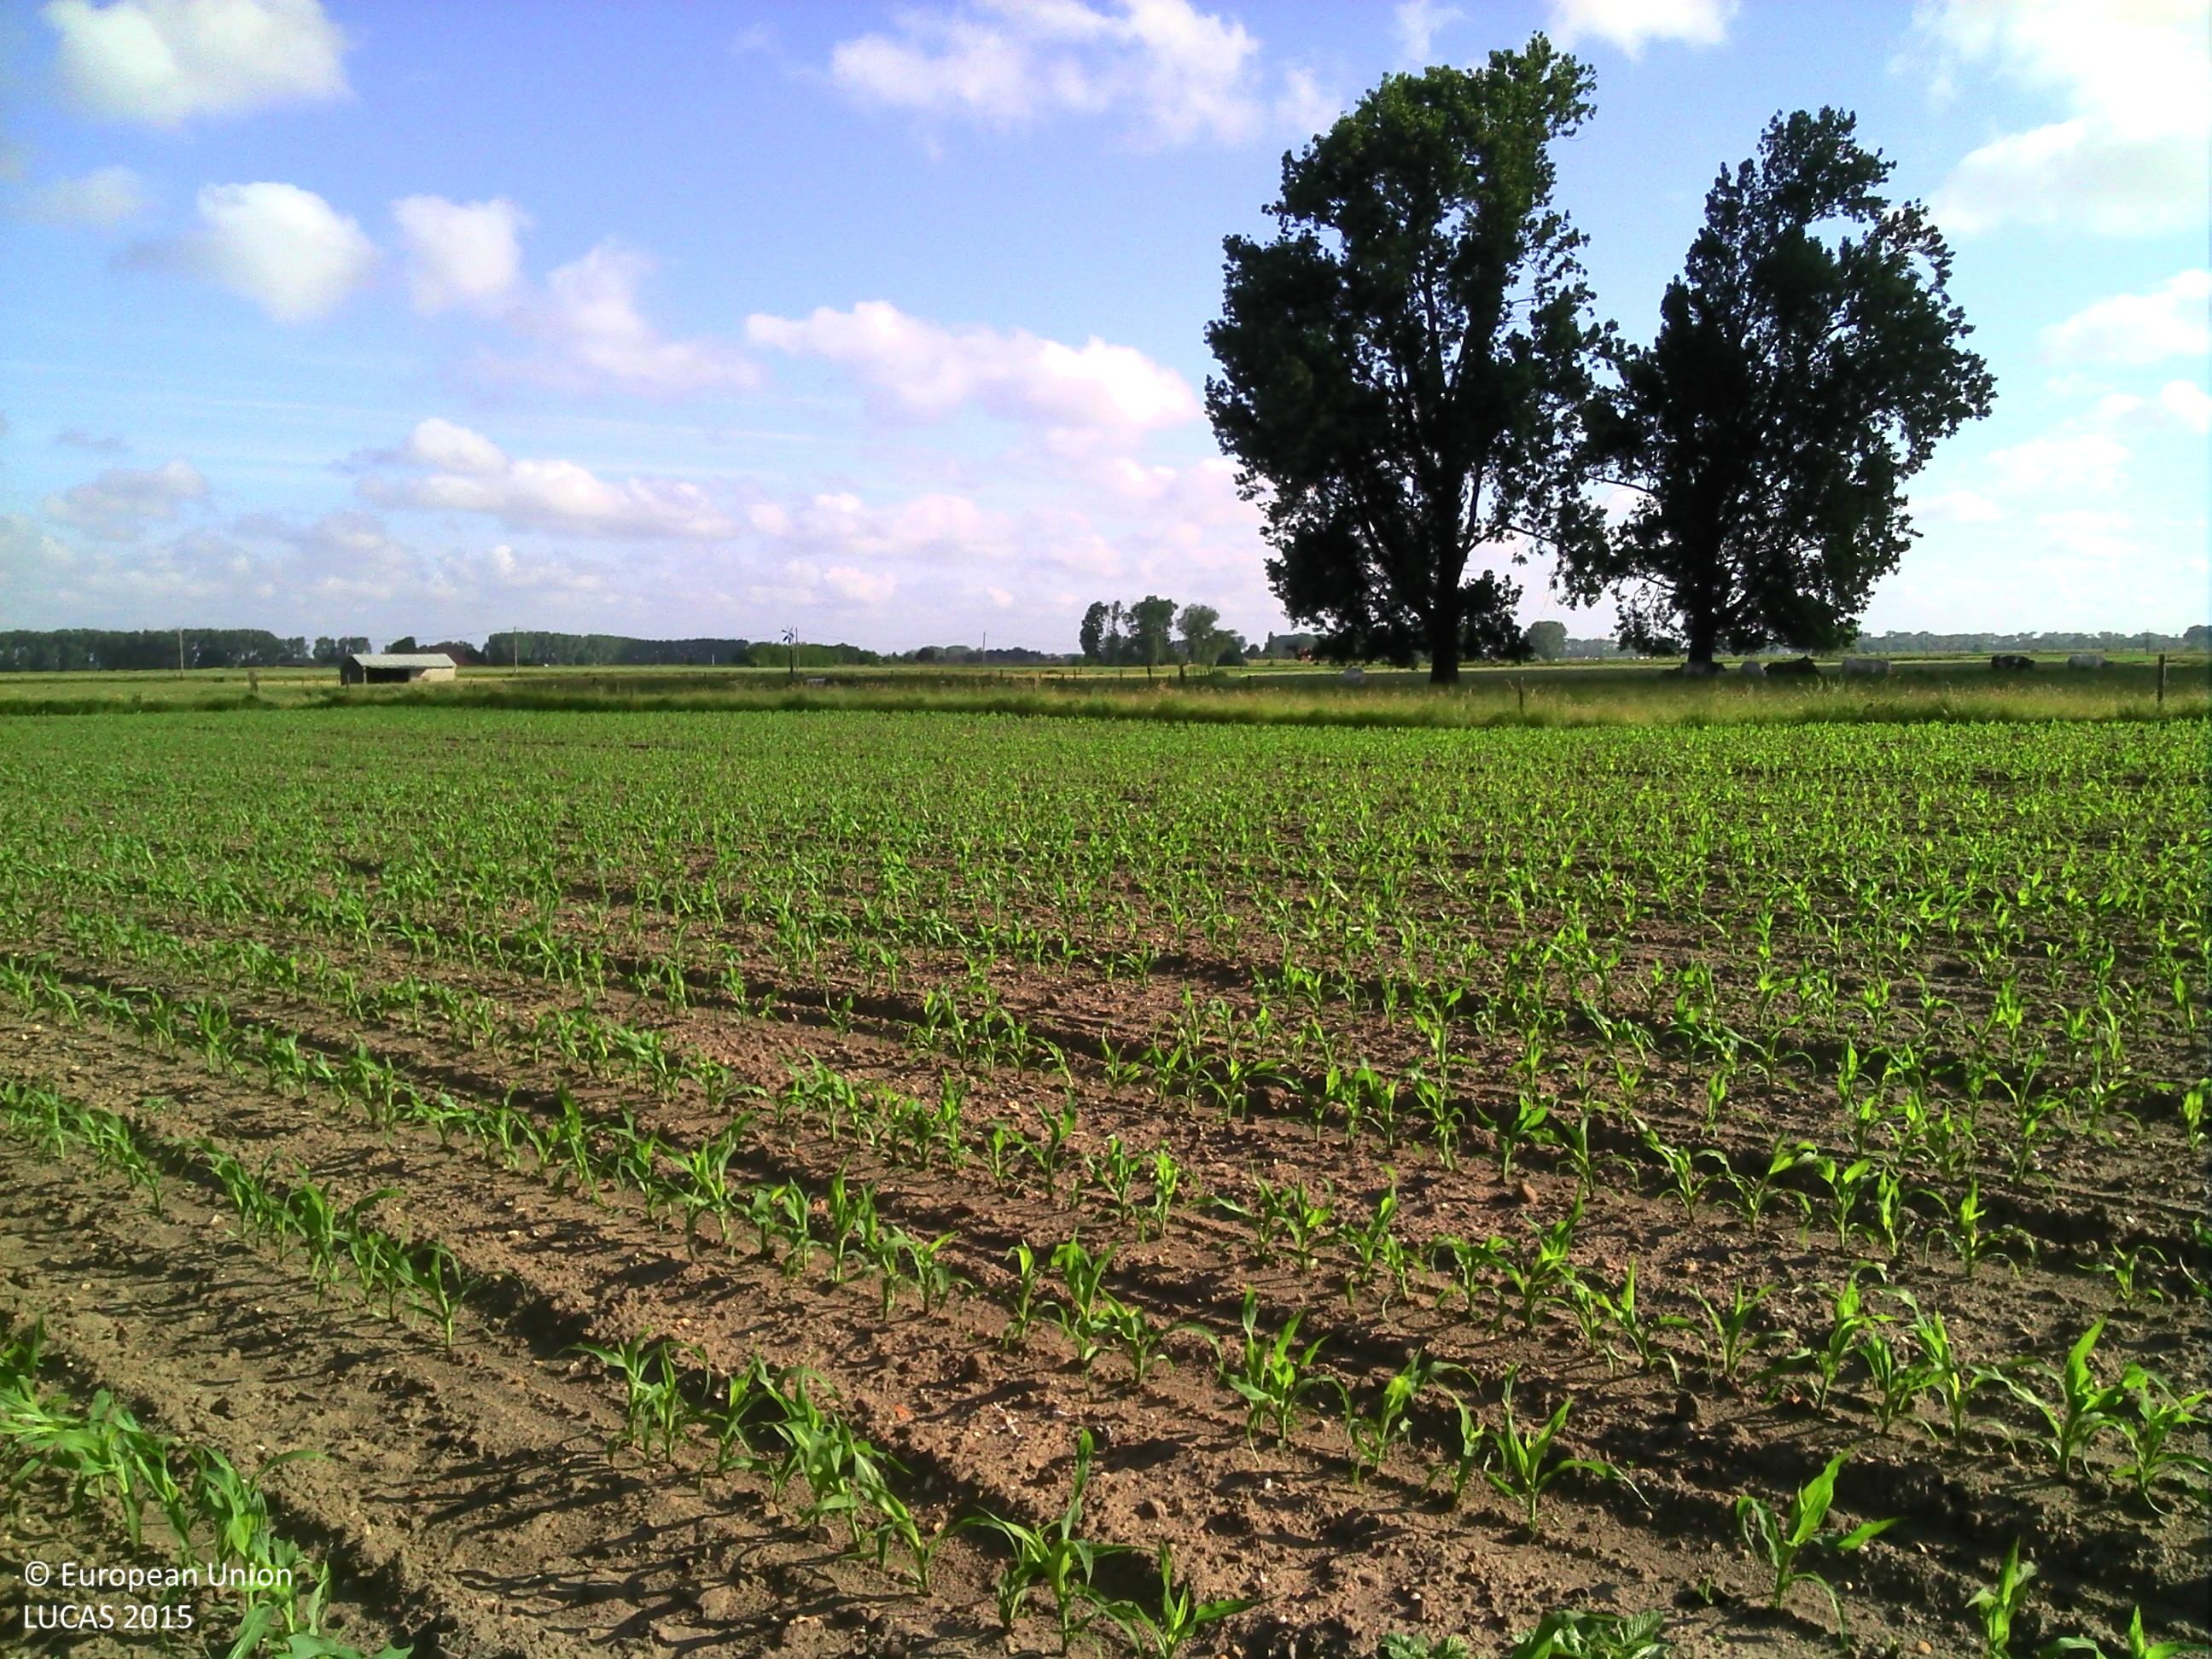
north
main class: Cropland
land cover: Maize
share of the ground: 10 - 25 %
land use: Agriculture (excluding fallow land and kitchen gardens)
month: June
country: BE
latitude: 51.0608
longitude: 5.7895
